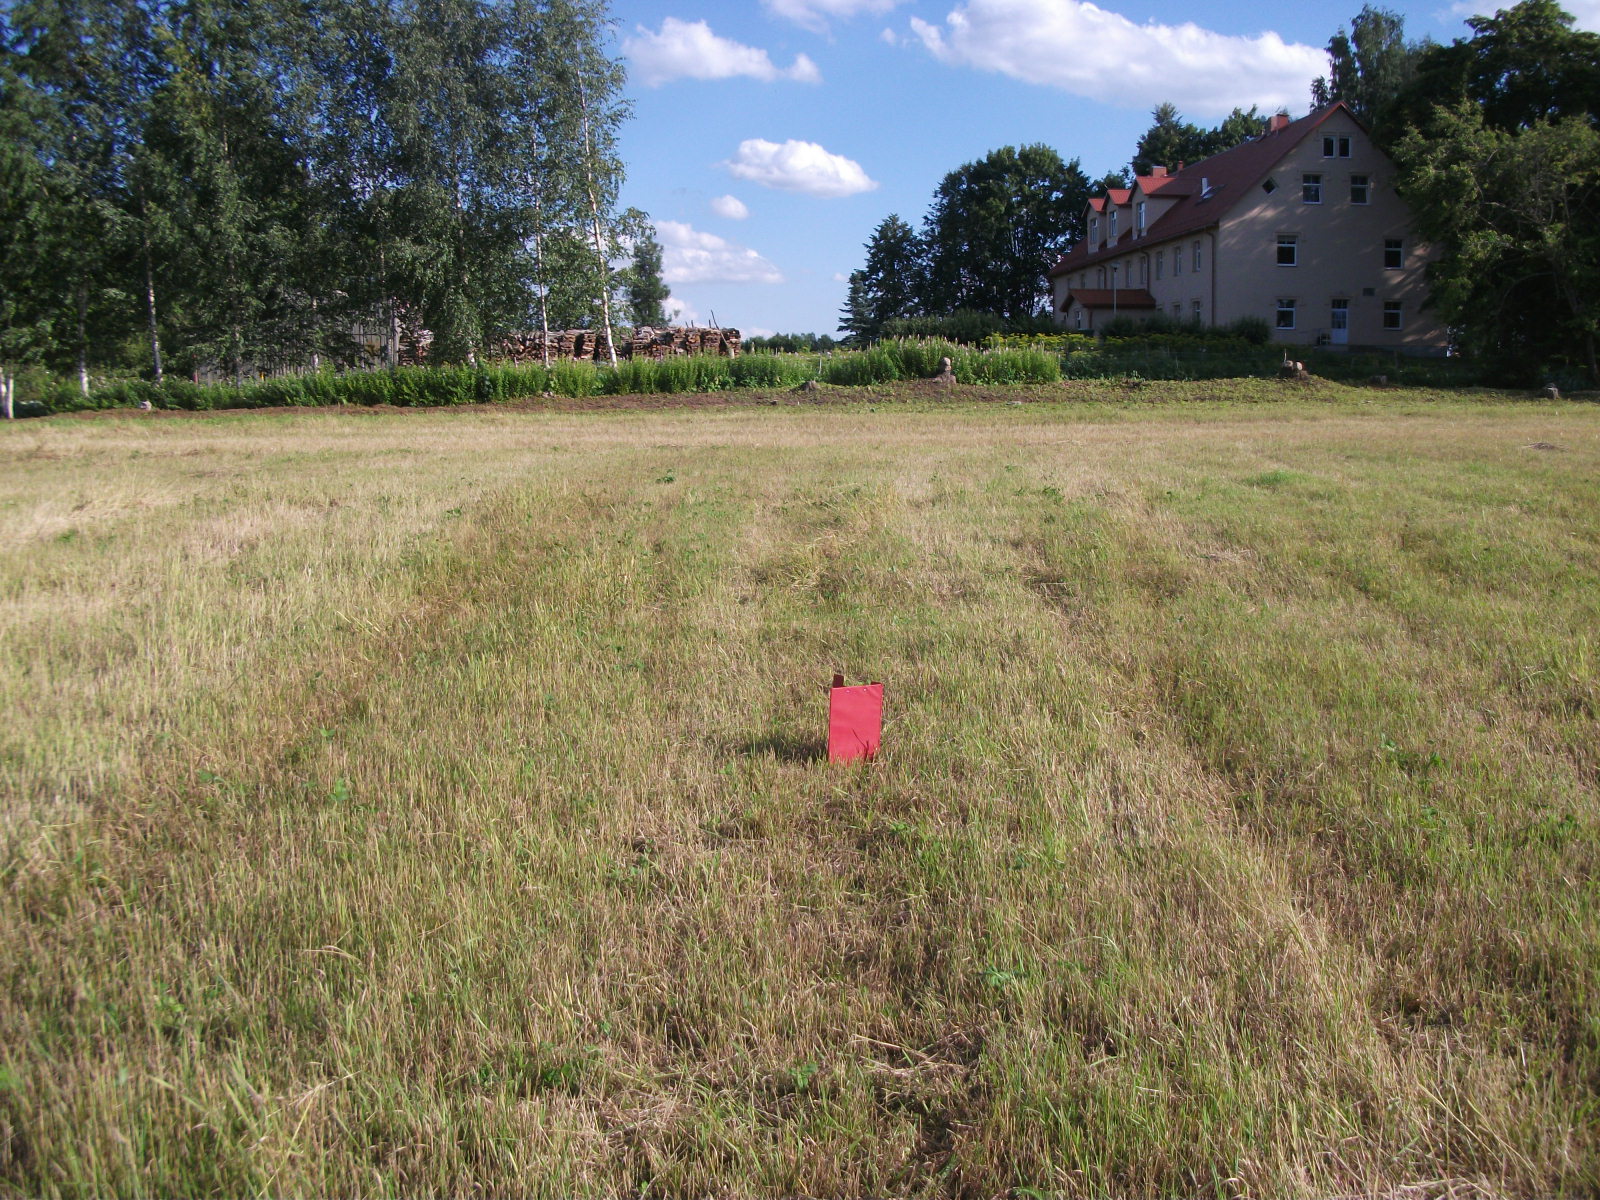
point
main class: Grassland
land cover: Grassland without tree/shrub cover
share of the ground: > 75 %
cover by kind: herbaceous plants 100 %
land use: Agriculture (excluding fallow land and kitchen gardens)
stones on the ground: < 10 %
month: August
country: LV
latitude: 57.0316
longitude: 26.5746
